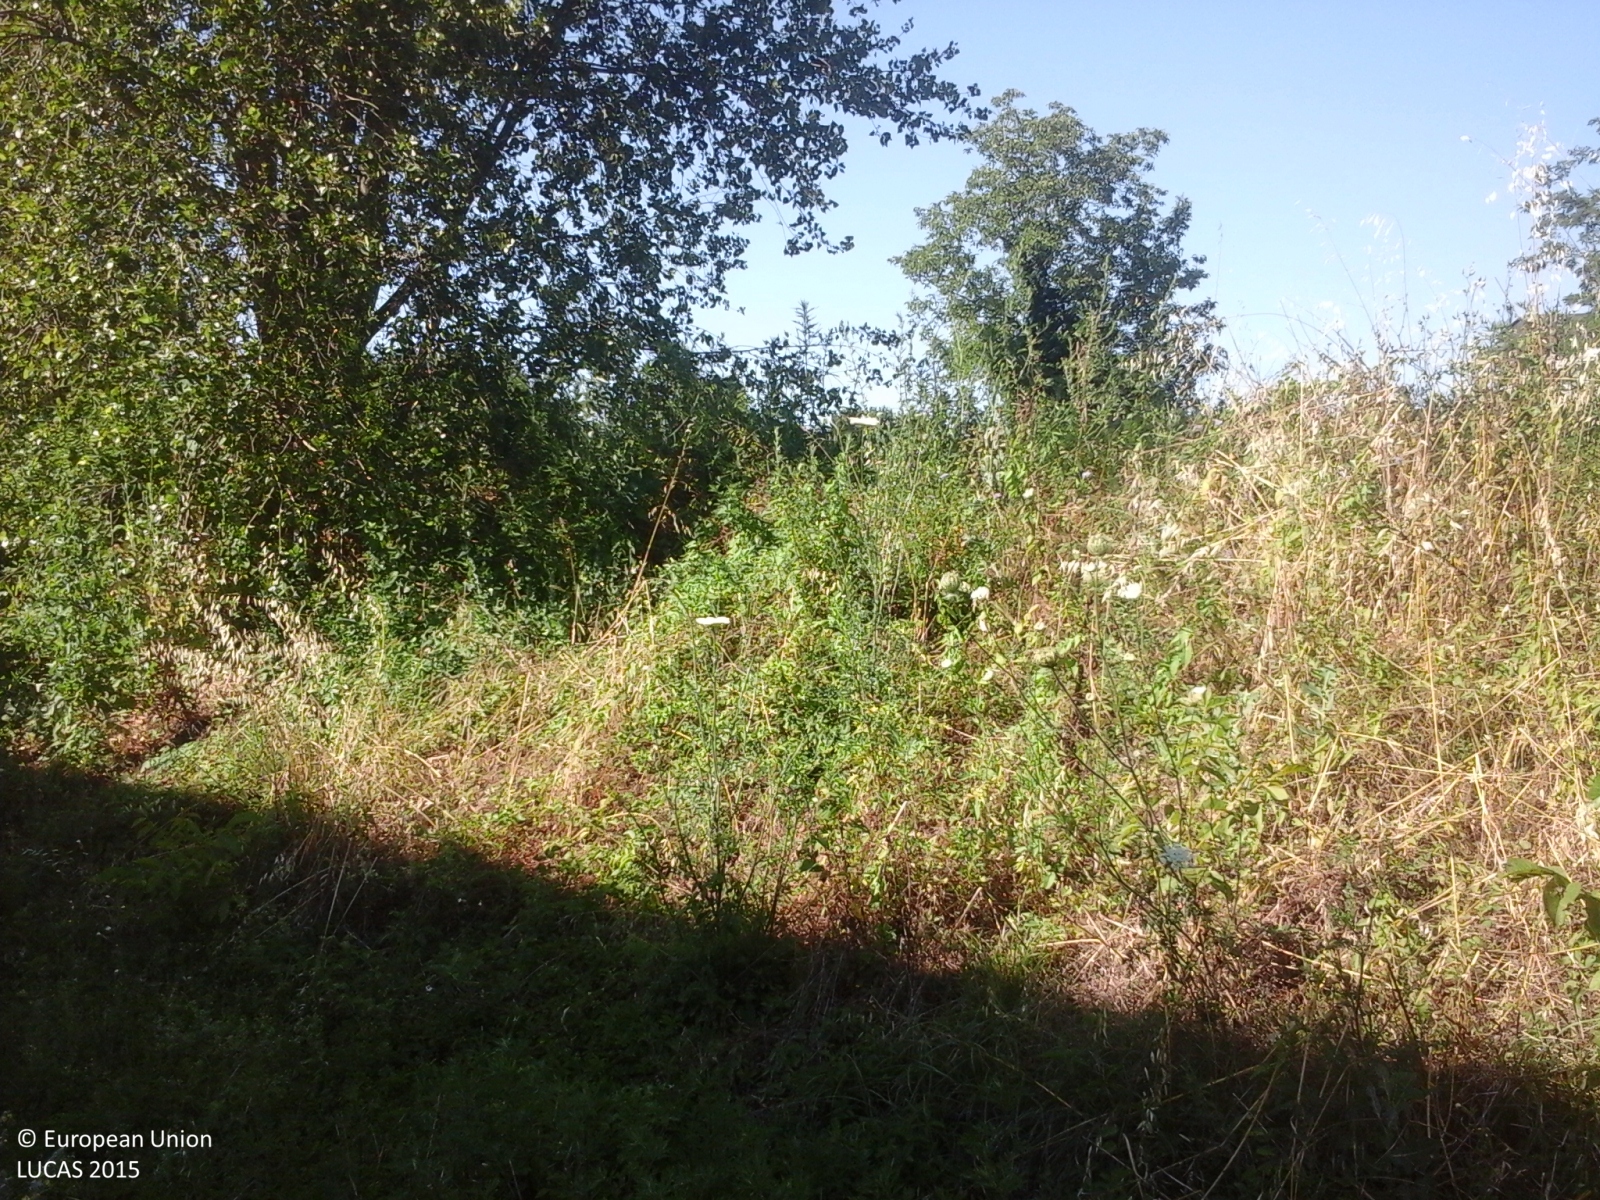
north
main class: Grassland
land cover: Grassland without tree/shrub cover
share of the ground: > 75 %
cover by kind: herbaceous plants 100 %
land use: Abandoned areas
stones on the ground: > 50 %
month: July
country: IT
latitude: 41.0277
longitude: 14.6322
